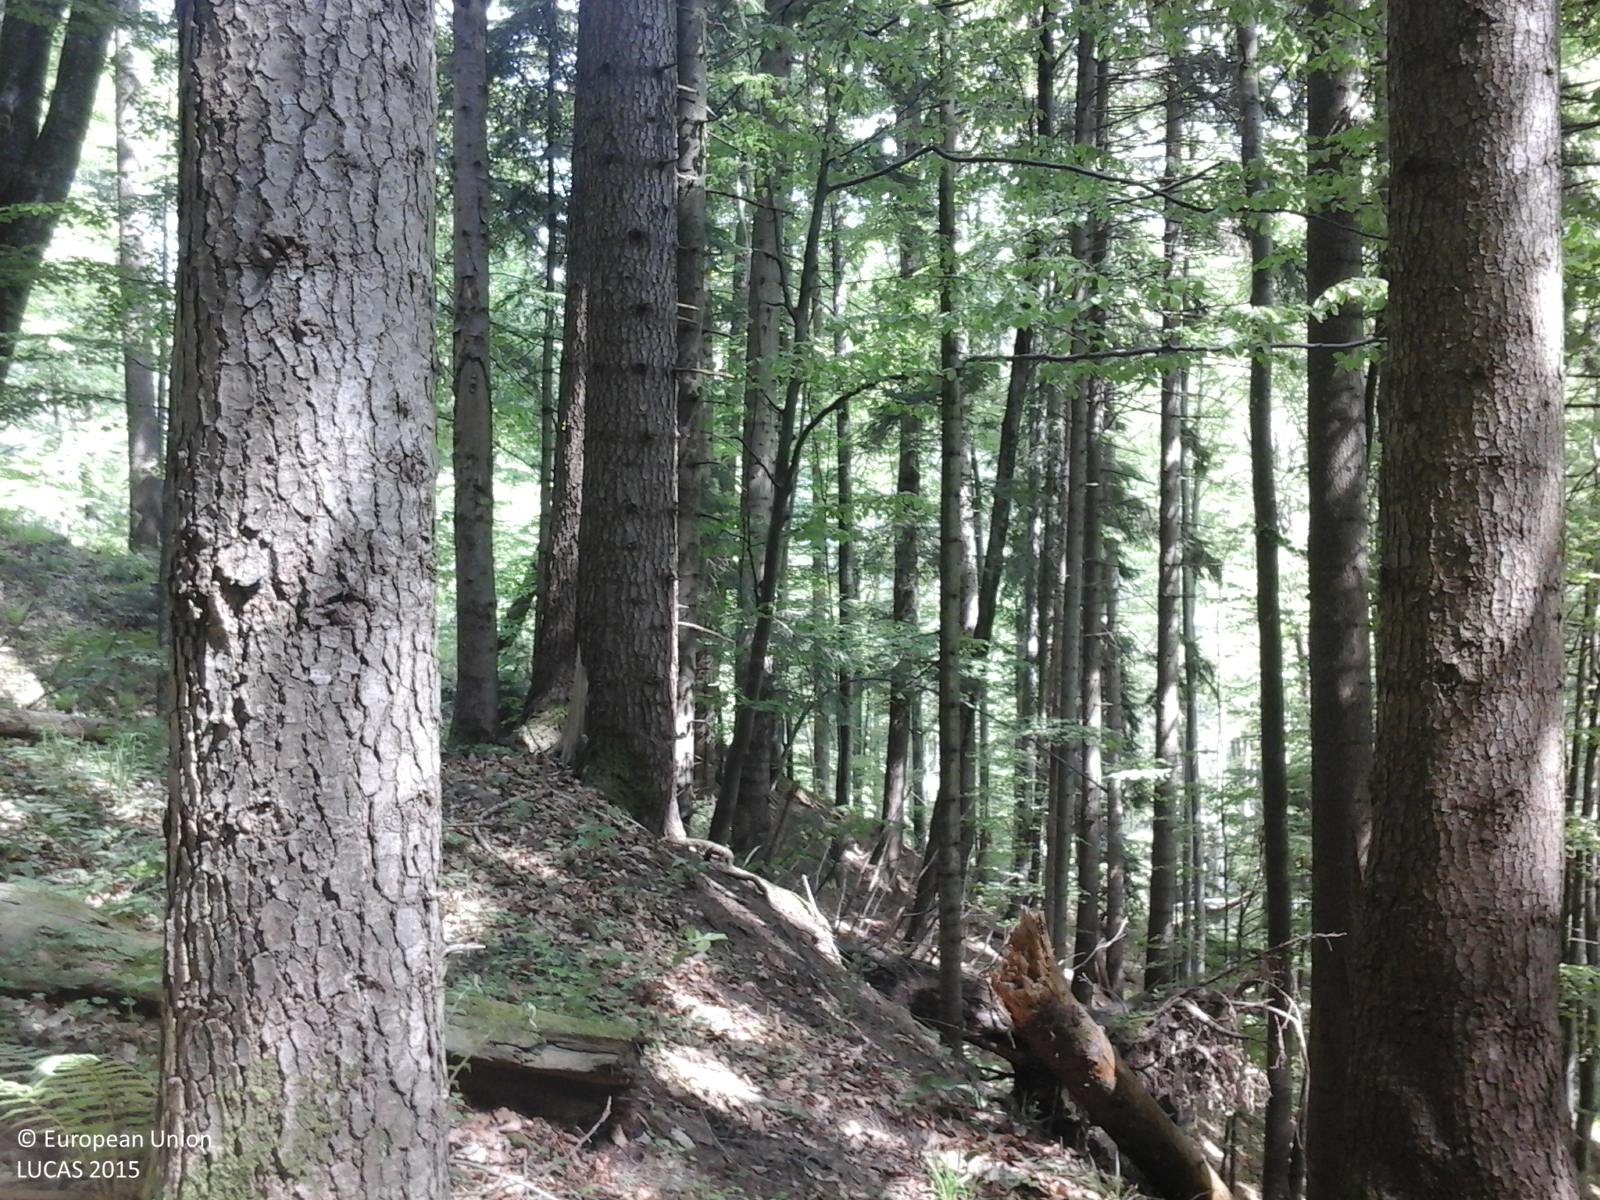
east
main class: Woodland
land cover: Spruce dominated mixed woodland
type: hemiboreal forest and nemoral coniferous forest and mixed broadleaved-coniferous forest
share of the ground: > 75 %
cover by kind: coniferous forest trees 60 %, broadleaved forest trees 40 %
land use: Forestry
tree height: > 5 m
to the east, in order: Spruce dominated mixed woodland
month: May
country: RO
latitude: 45.5494
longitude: 26.2983
